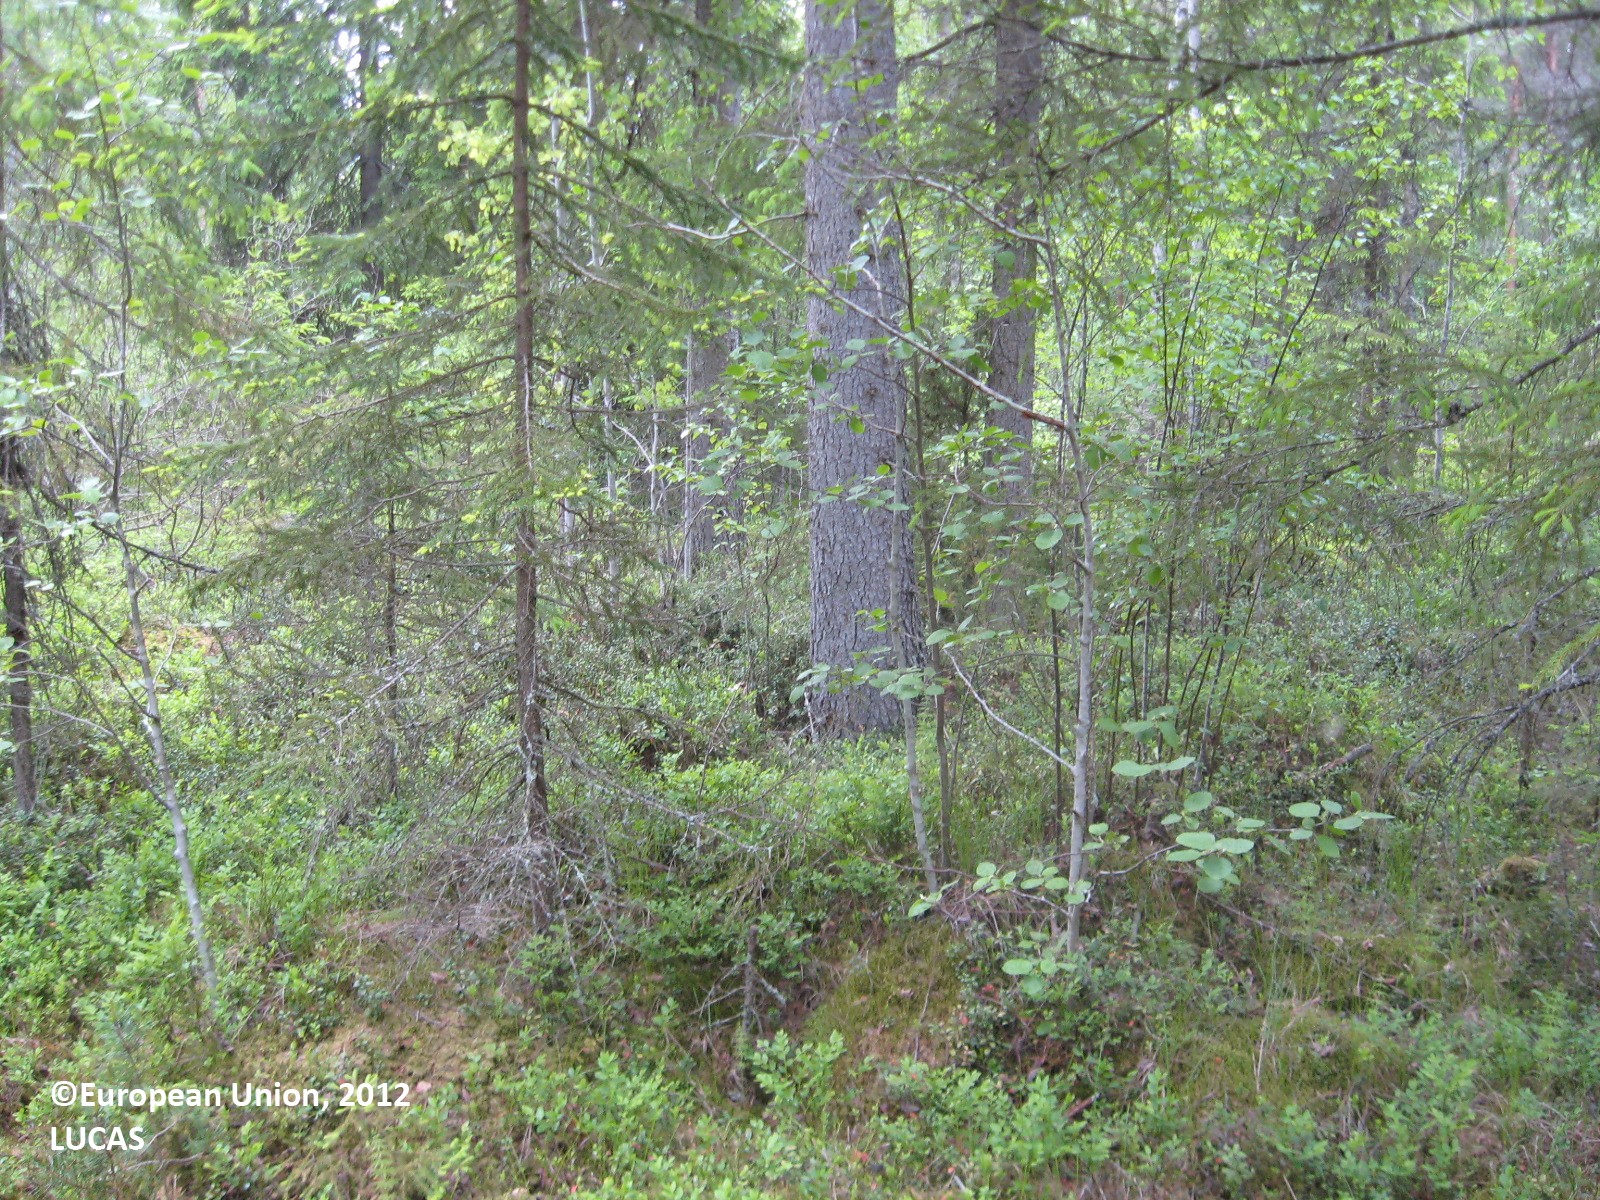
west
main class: Woodland
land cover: Spruce dominated mixed woodland
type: boreal forest
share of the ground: > 75 %
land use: Forestry
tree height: > 5 m
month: June
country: FI
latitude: 63.0579
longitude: 22.7351
